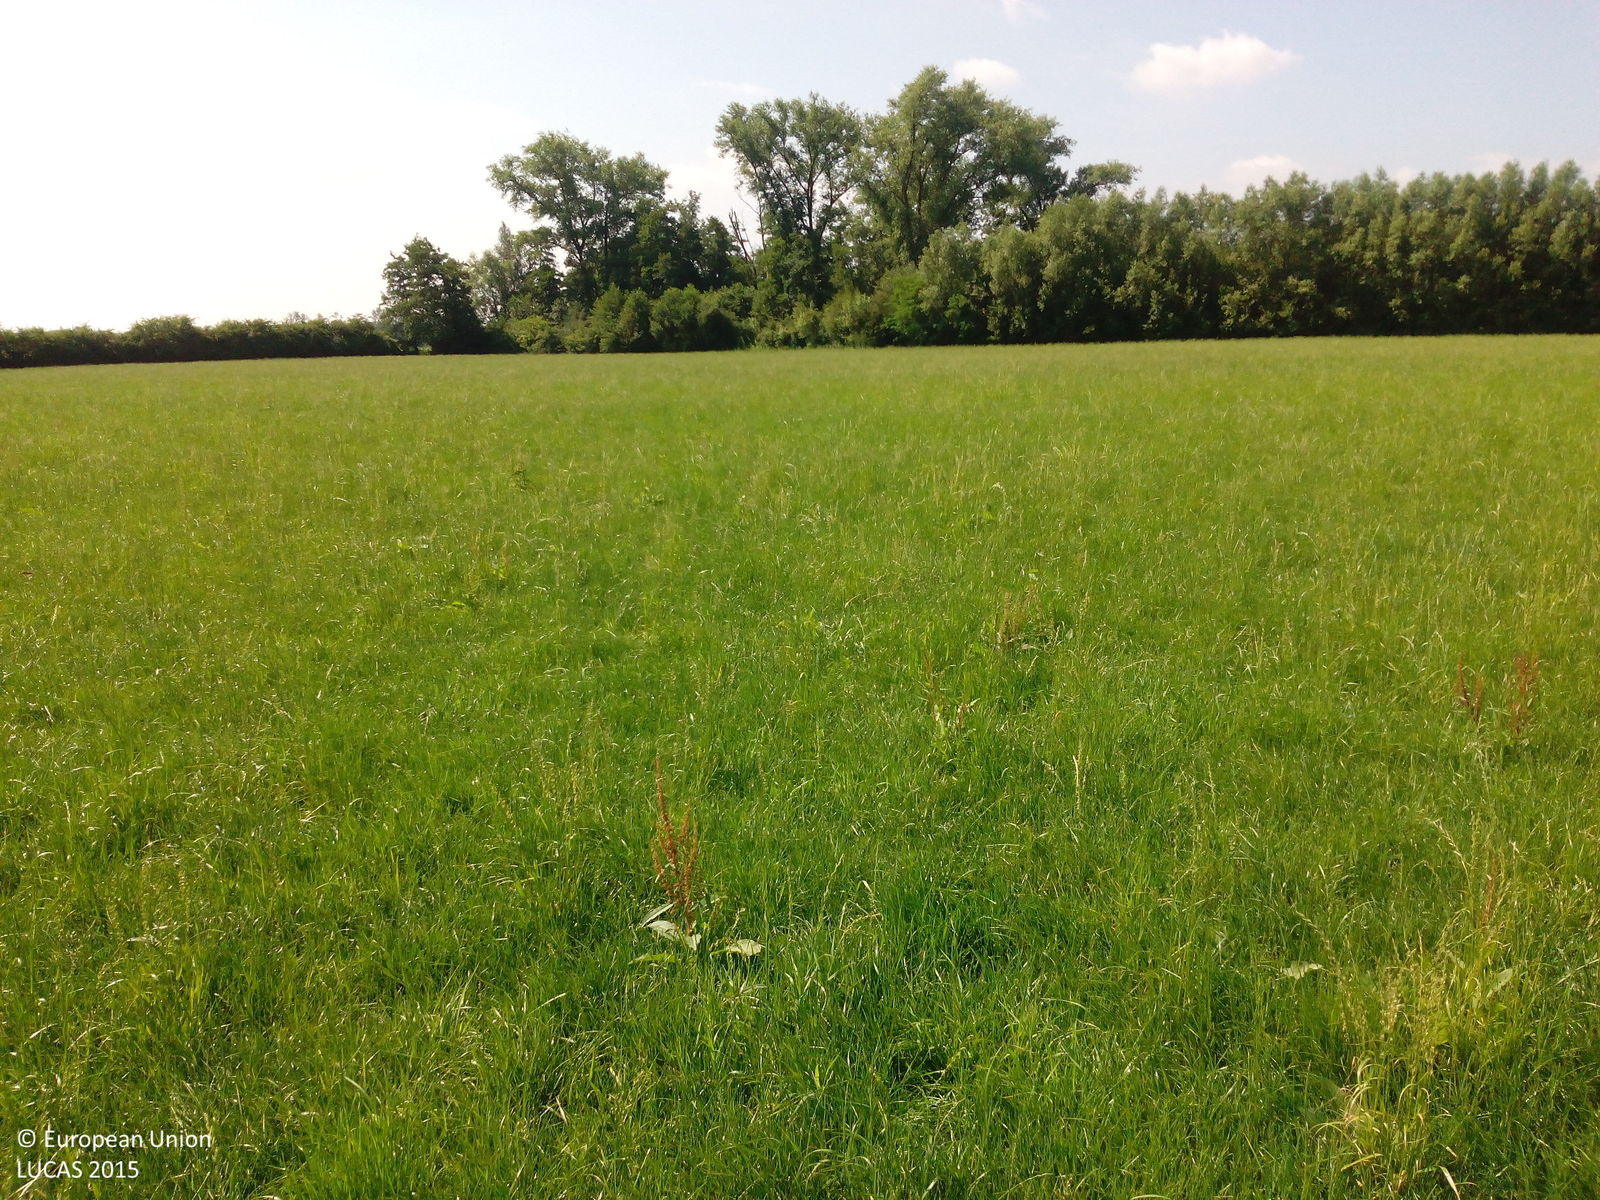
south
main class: Grassland
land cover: Grassland without tree/shrub cover
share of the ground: > 75 %
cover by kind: herbaceous plants 100 %
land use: Agriculture (excluding fallow land and kitchen gardens)
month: July
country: NL
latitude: 51.9757
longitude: 6.2289
